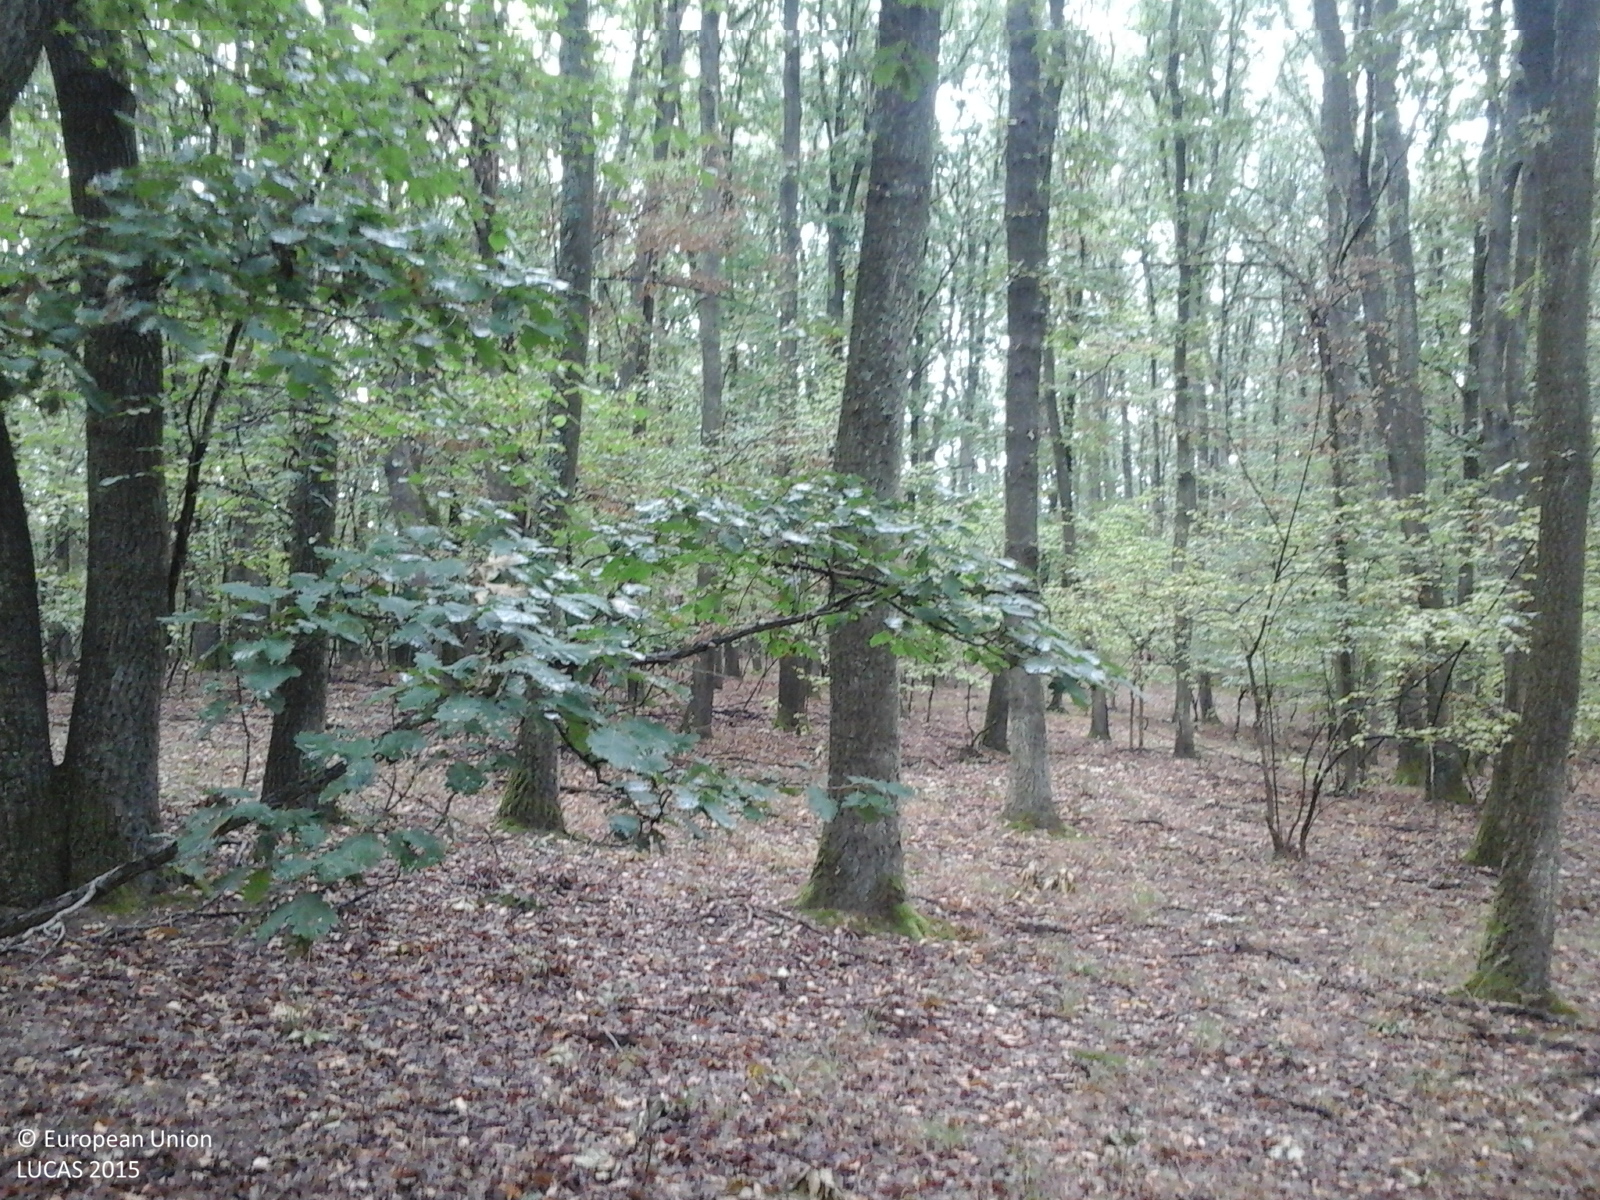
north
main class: Woodland
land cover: Broadleaved woodland
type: acidophilous oak and oak-birch forest
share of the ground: > 75 %
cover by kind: broadleaved forest trees 100 %
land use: Forestry
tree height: > 5 m
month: September
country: RO
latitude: 47.2376
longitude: 22.3248
